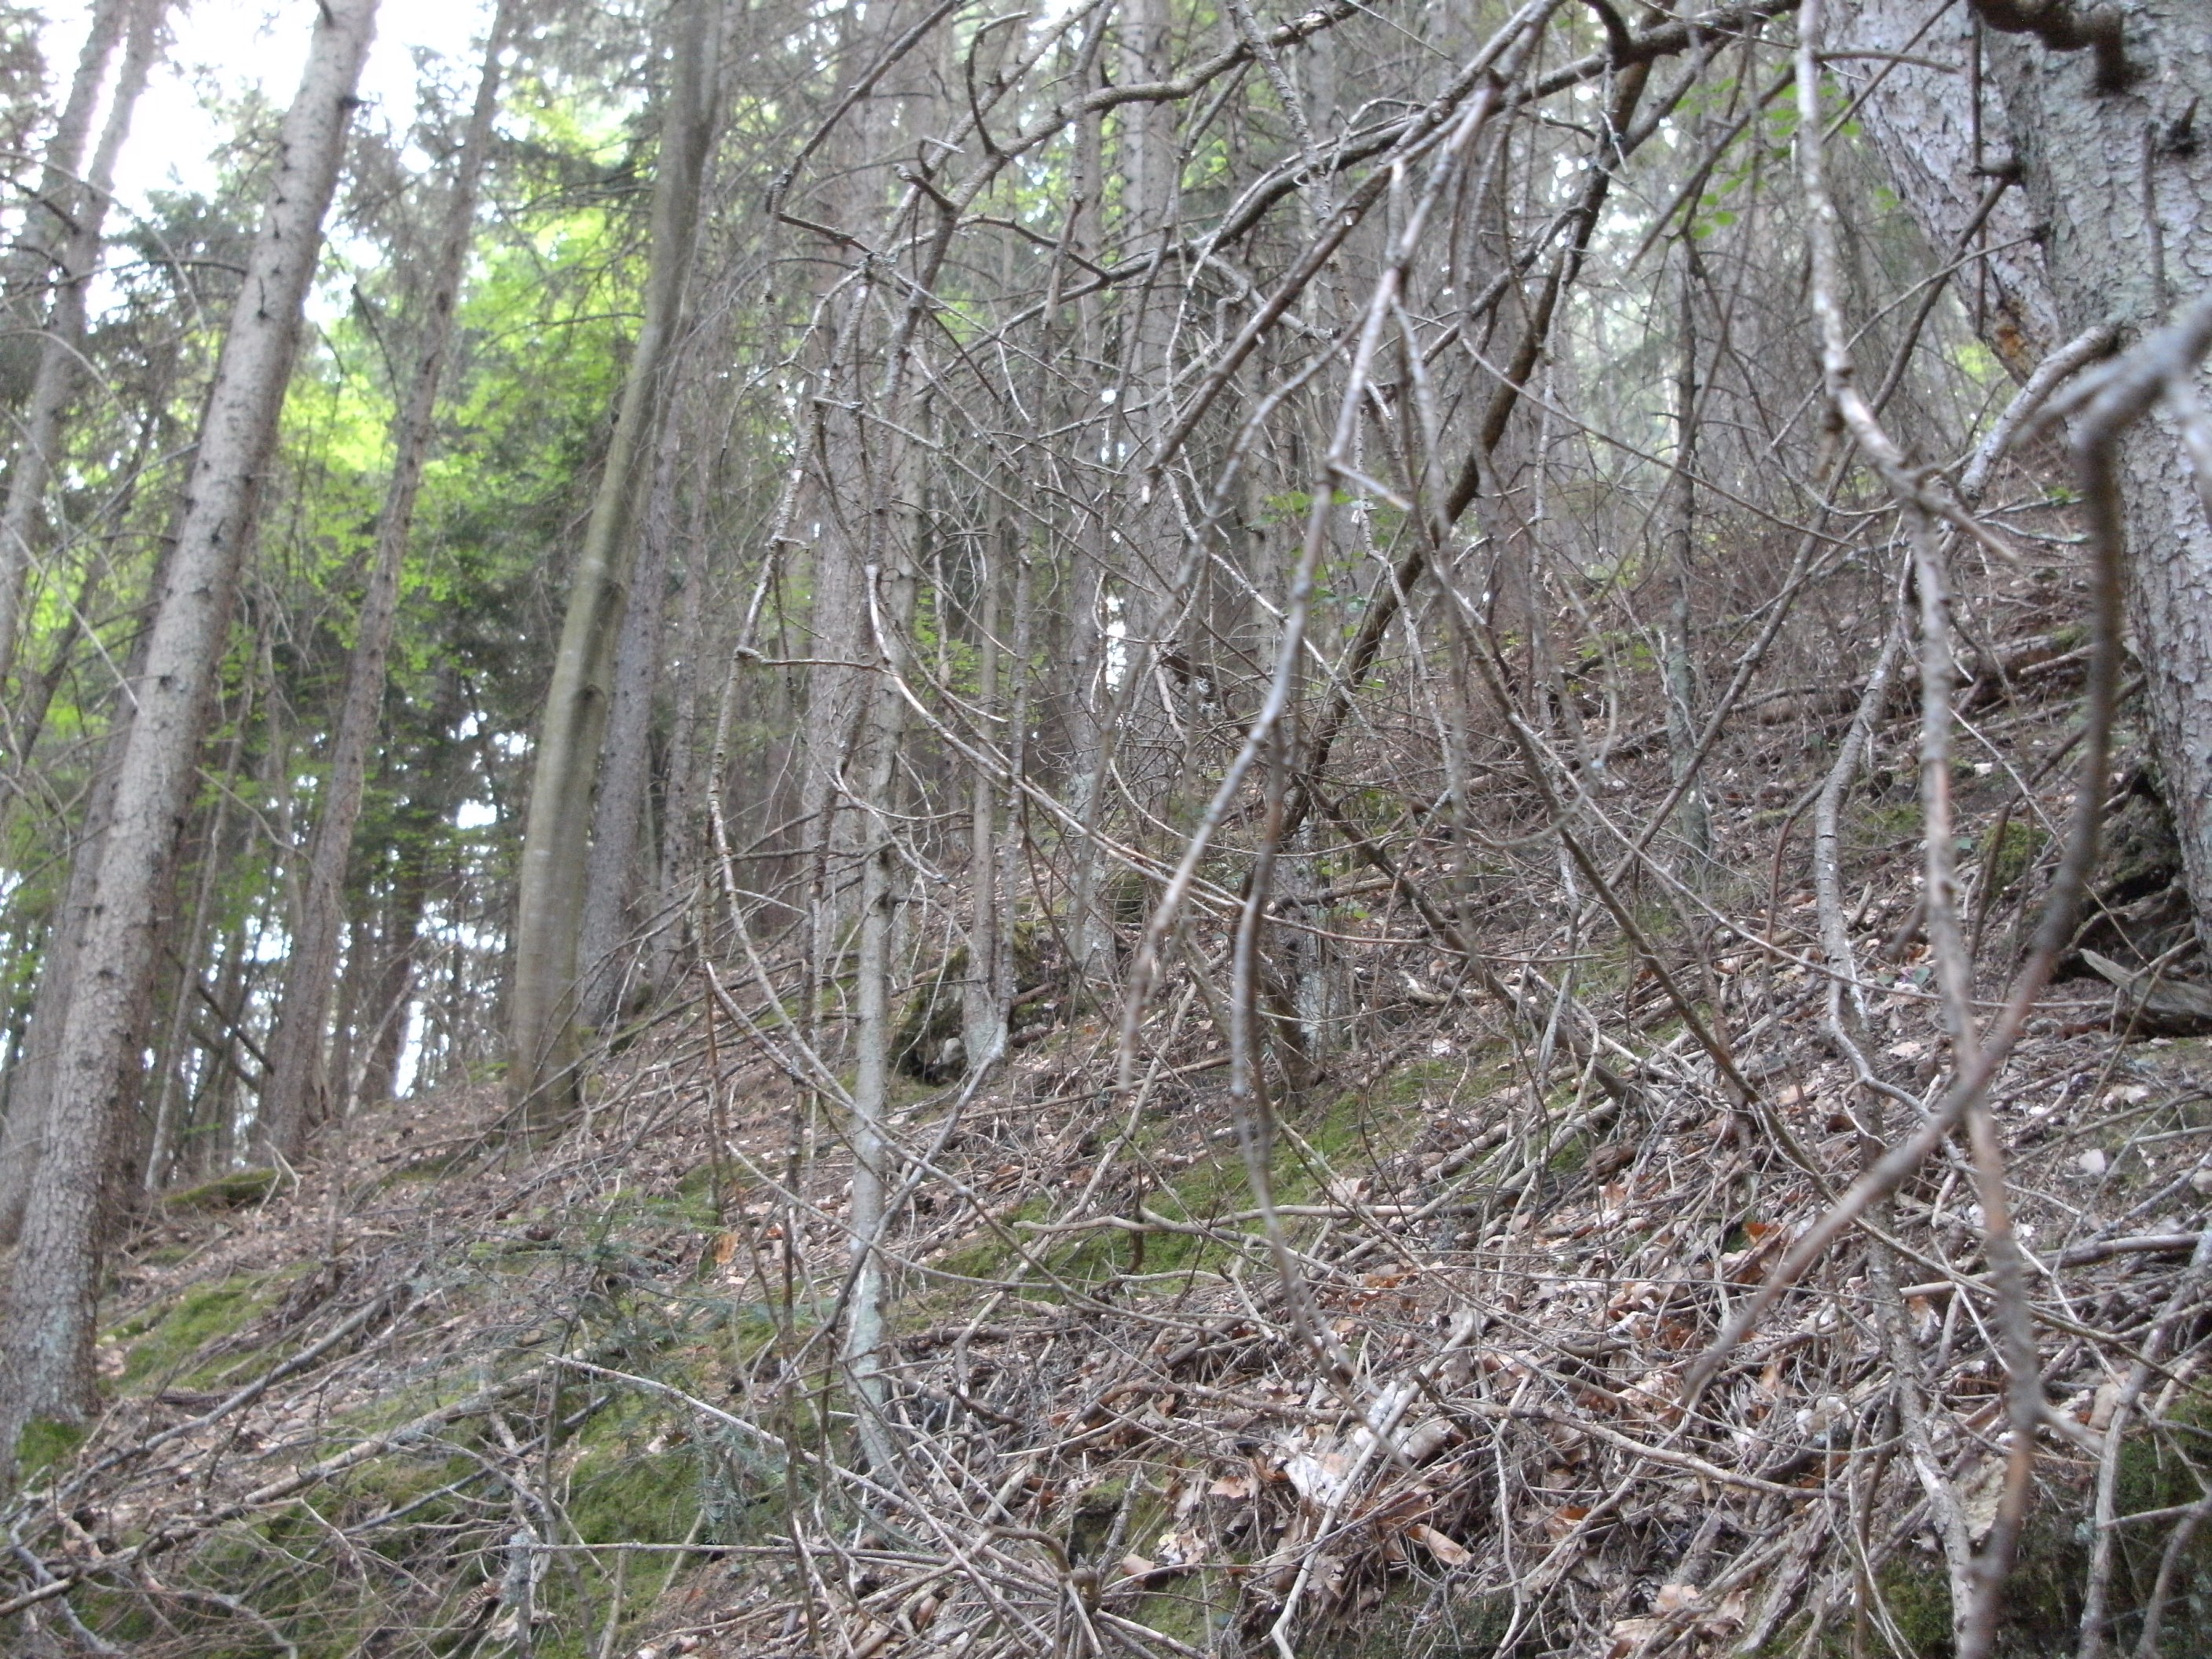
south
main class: Woodland
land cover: Spruce dominated coniferous woodland
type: hemiboreal forest and nemoral coniferous forest and mixed broadleaved-coniferous forest
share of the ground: > 75 %
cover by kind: coniferous forest trees 65 %, broadleaved forest trees 20 %, unconsolidated bare surface 10 %, lichens and mosses 5 %
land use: Forestry
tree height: > 5 m
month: July
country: AT
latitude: 46.5375
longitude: 14.6787
